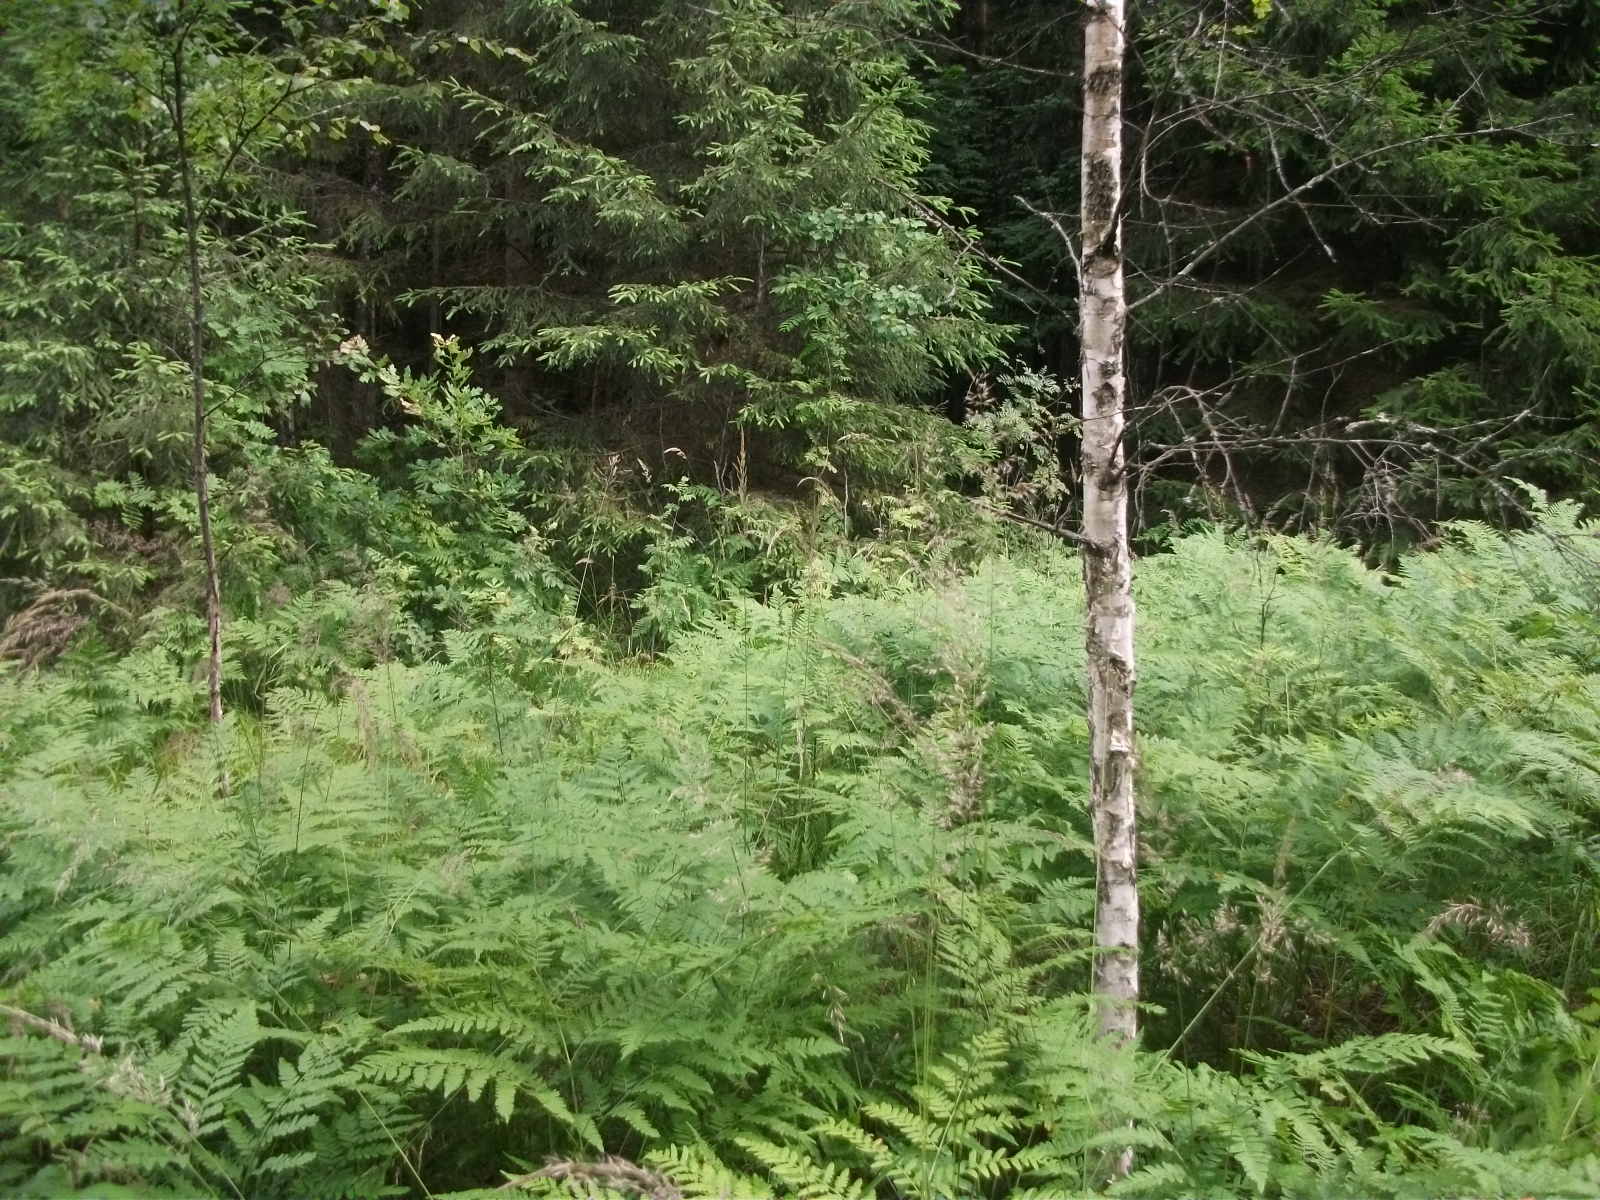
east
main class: Woodland
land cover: Spruce dominated mixed woodland
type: hemiboreal forest and nemoral coniferous forest and mixed broadleaved-coniferous forest
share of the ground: 50 - 75 %
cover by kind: coniferous forest trees 50 %, broadleaved forest trees 20 %, shrubs 15 %, herbaceous plants 15 %
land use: Forestry
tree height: > 5 m
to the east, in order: Spruce dominated mixed woodland; Other mixed woodland; Electric lines; Other mixed woodland; Broadleaved woodland; Ditches and canals; Broadleaved woodland; Spruce dominated mixed woodland; Shrubland with sparse tree cover
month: July
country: LV
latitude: 56.9205
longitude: 25.8486
